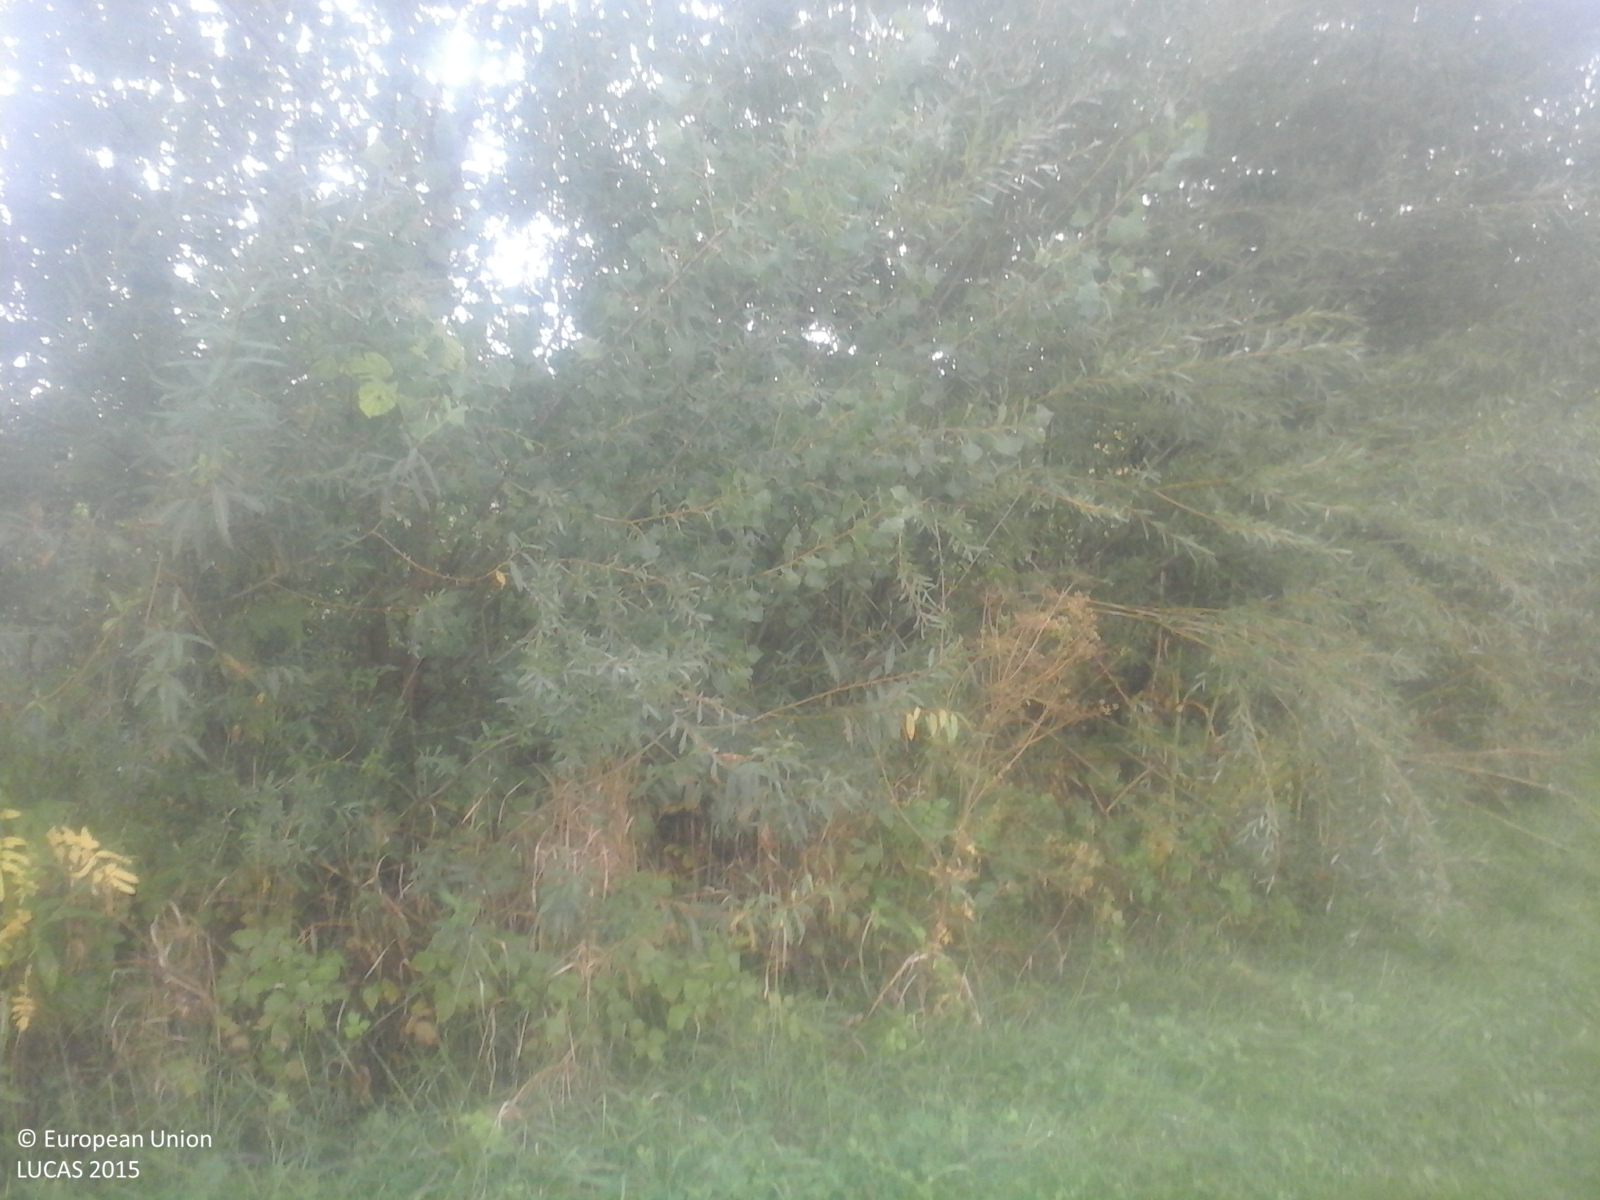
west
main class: Cropland
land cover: Maize
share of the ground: > 75 %
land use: Agriculture (excluding fallow land and kitchen gardens)
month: September
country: RO
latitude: 46.8034
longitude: 22.3018
